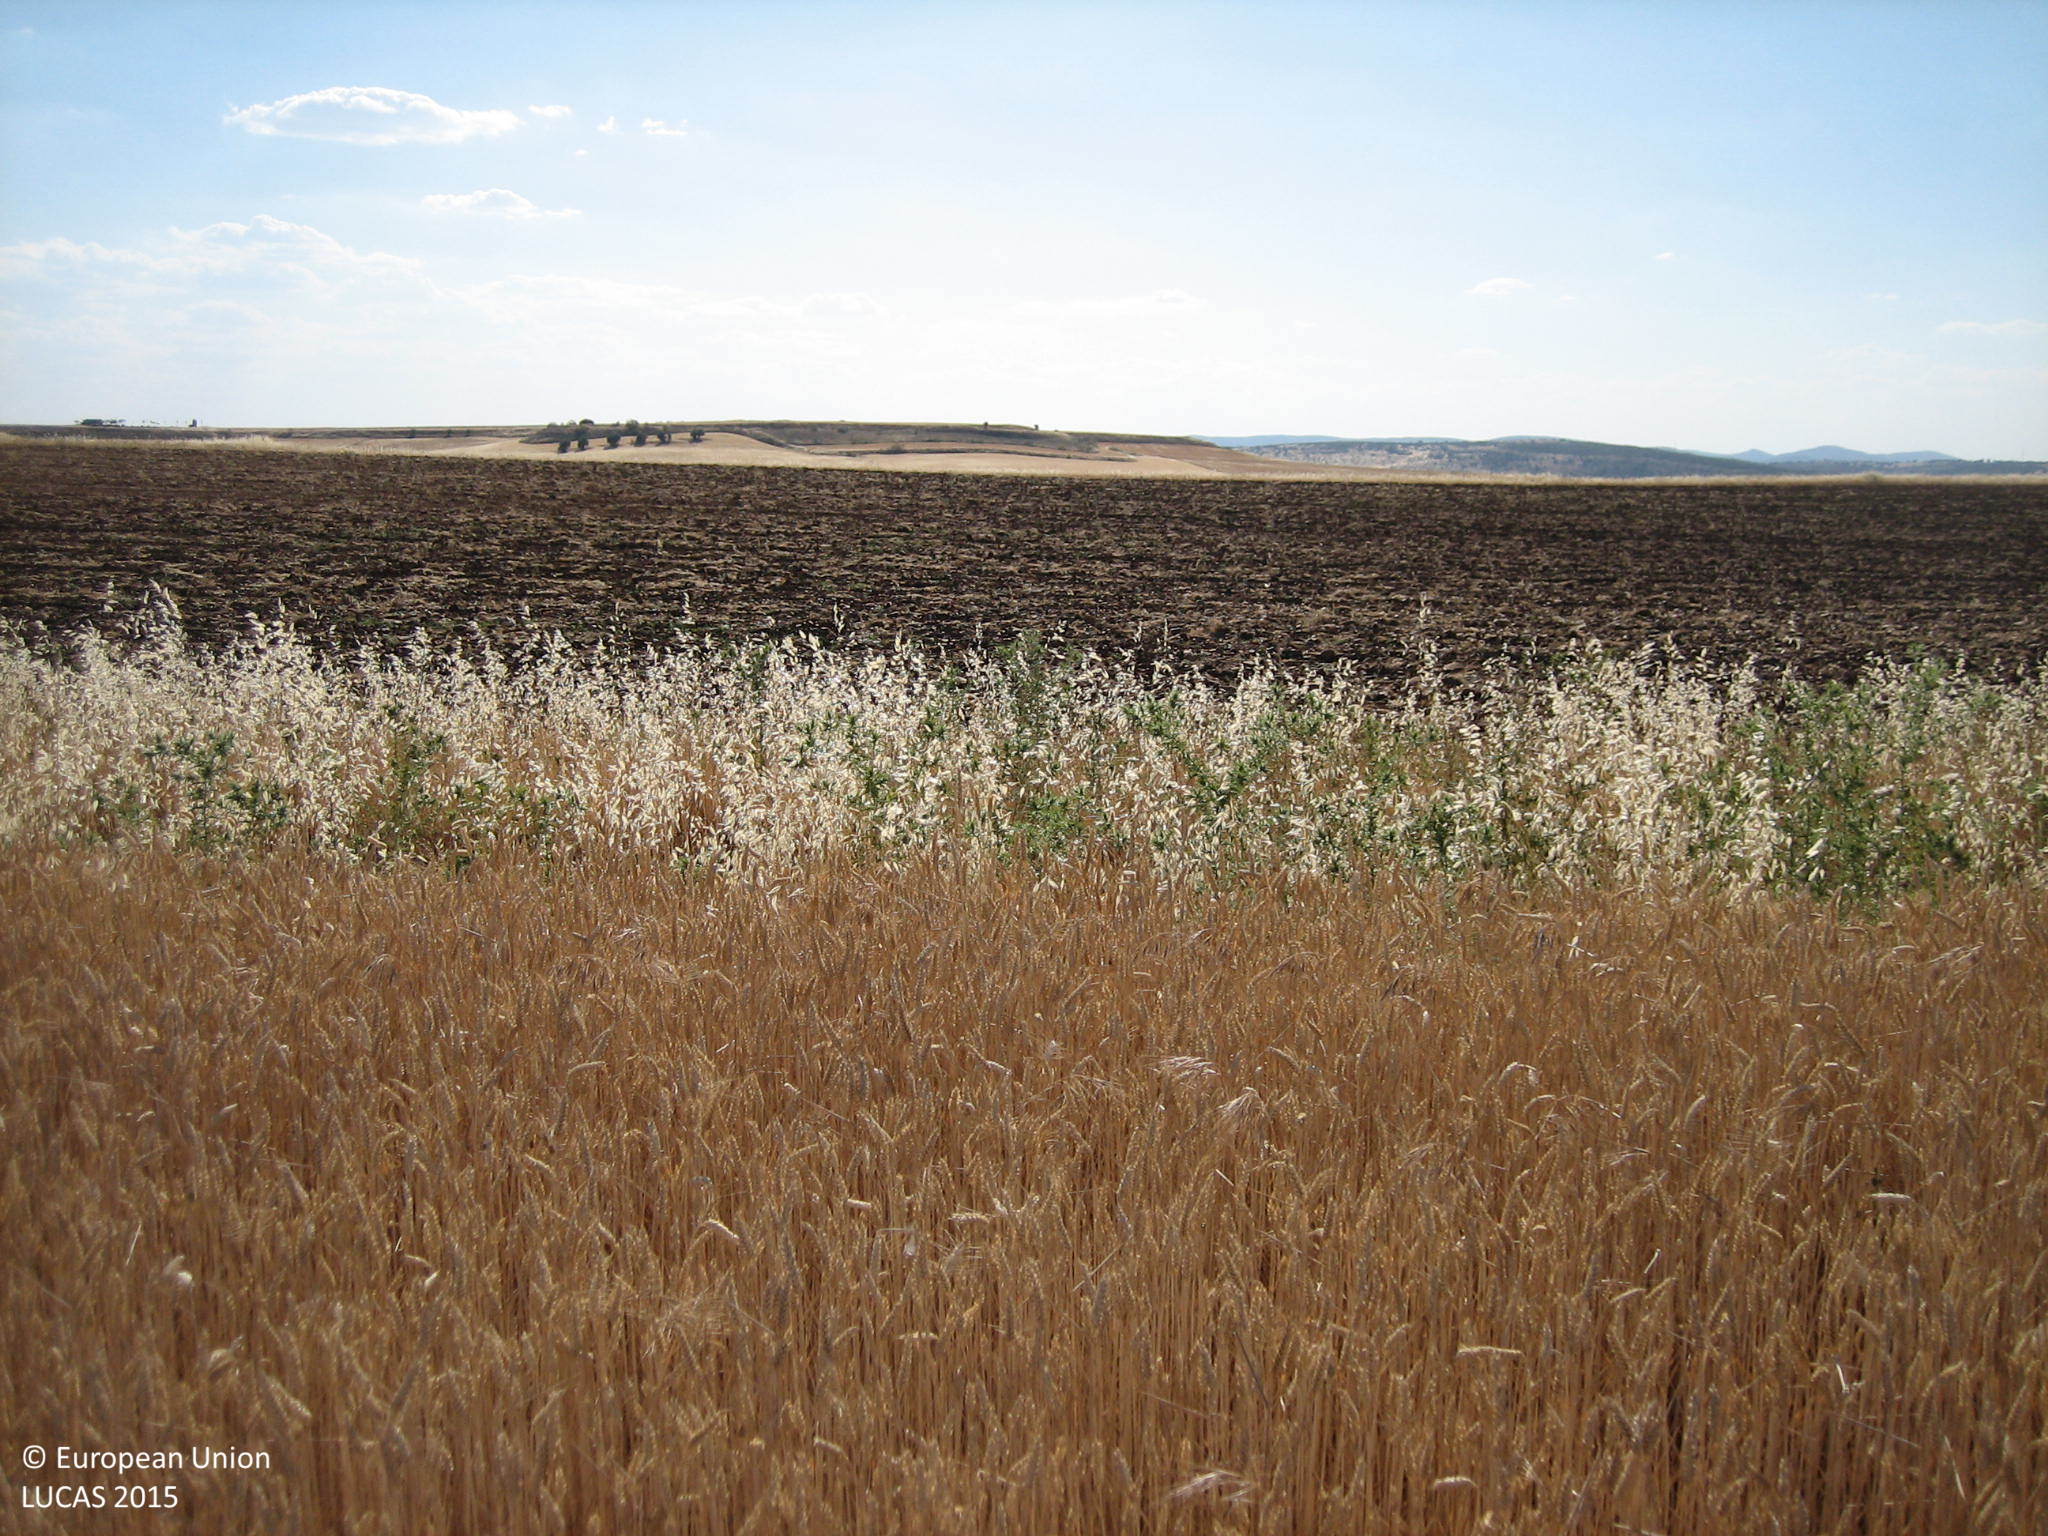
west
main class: Cropland
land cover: Common wheat
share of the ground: > 75 %
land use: Agriculture (excluding fallow land and kitchen gardens)
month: June
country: ES
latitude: 38.8806
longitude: -4.0726
